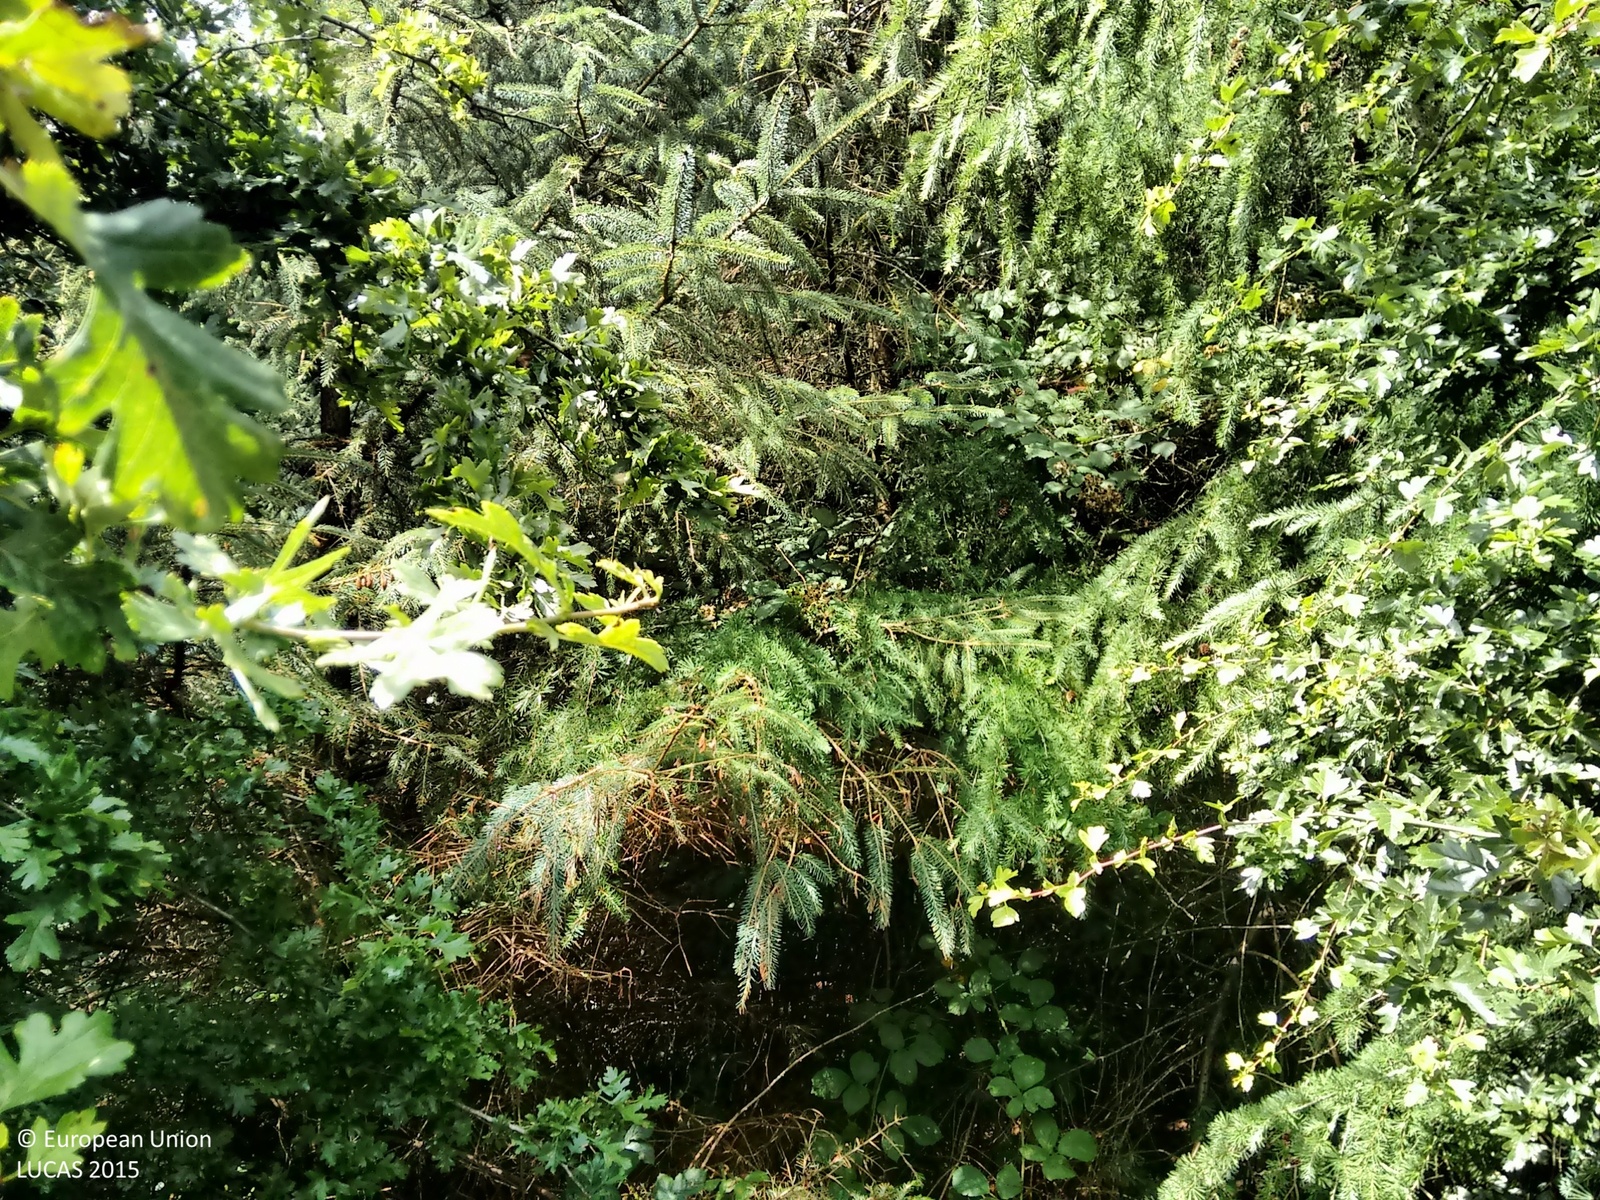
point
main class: Woodland
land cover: Spruce dominated mixed woodland
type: exotic forest
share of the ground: > 75 %
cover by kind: coniferous forest trees 75 %, broadleaved forest trees 25 %
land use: Forestry
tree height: > 5 m
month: August
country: IE
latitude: 52.6432
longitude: -6.2441
